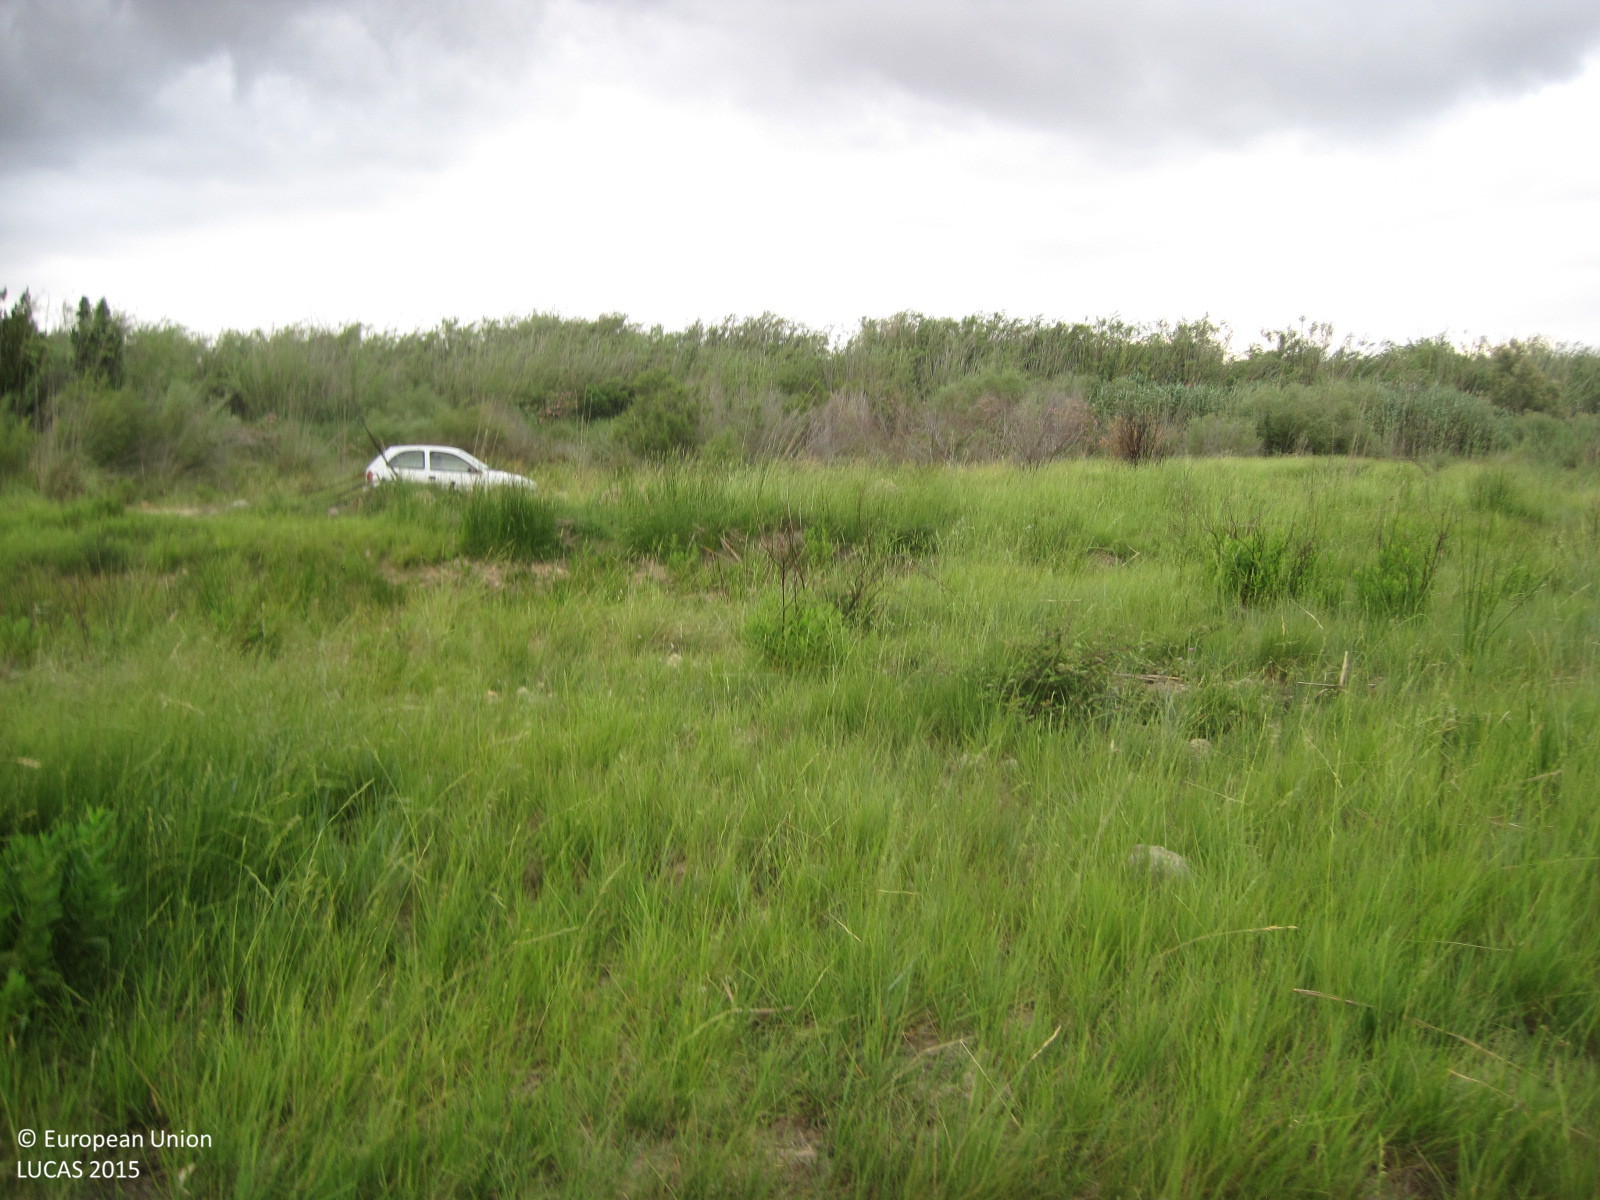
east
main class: Grassland
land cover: Grassland without tree/shrub cover
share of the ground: 50 - 75 %
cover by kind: herbaceous plants 70 %, unconsolidated bare surface 25 %, shrubs 5 %
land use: Semi-natural and natural areas not in use
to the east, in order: Grassland without tree/shrub cover; Tracks; Shrubland without tree cover; Inland fresh running water; Shrubland without tree cover; Spontaneously vegetated surfaces; Paved roads, cycling and walking lanes; Ditches and canals; Other fruit trees and berries
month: June
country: ES
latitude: 39.2767
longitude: -0.5563
